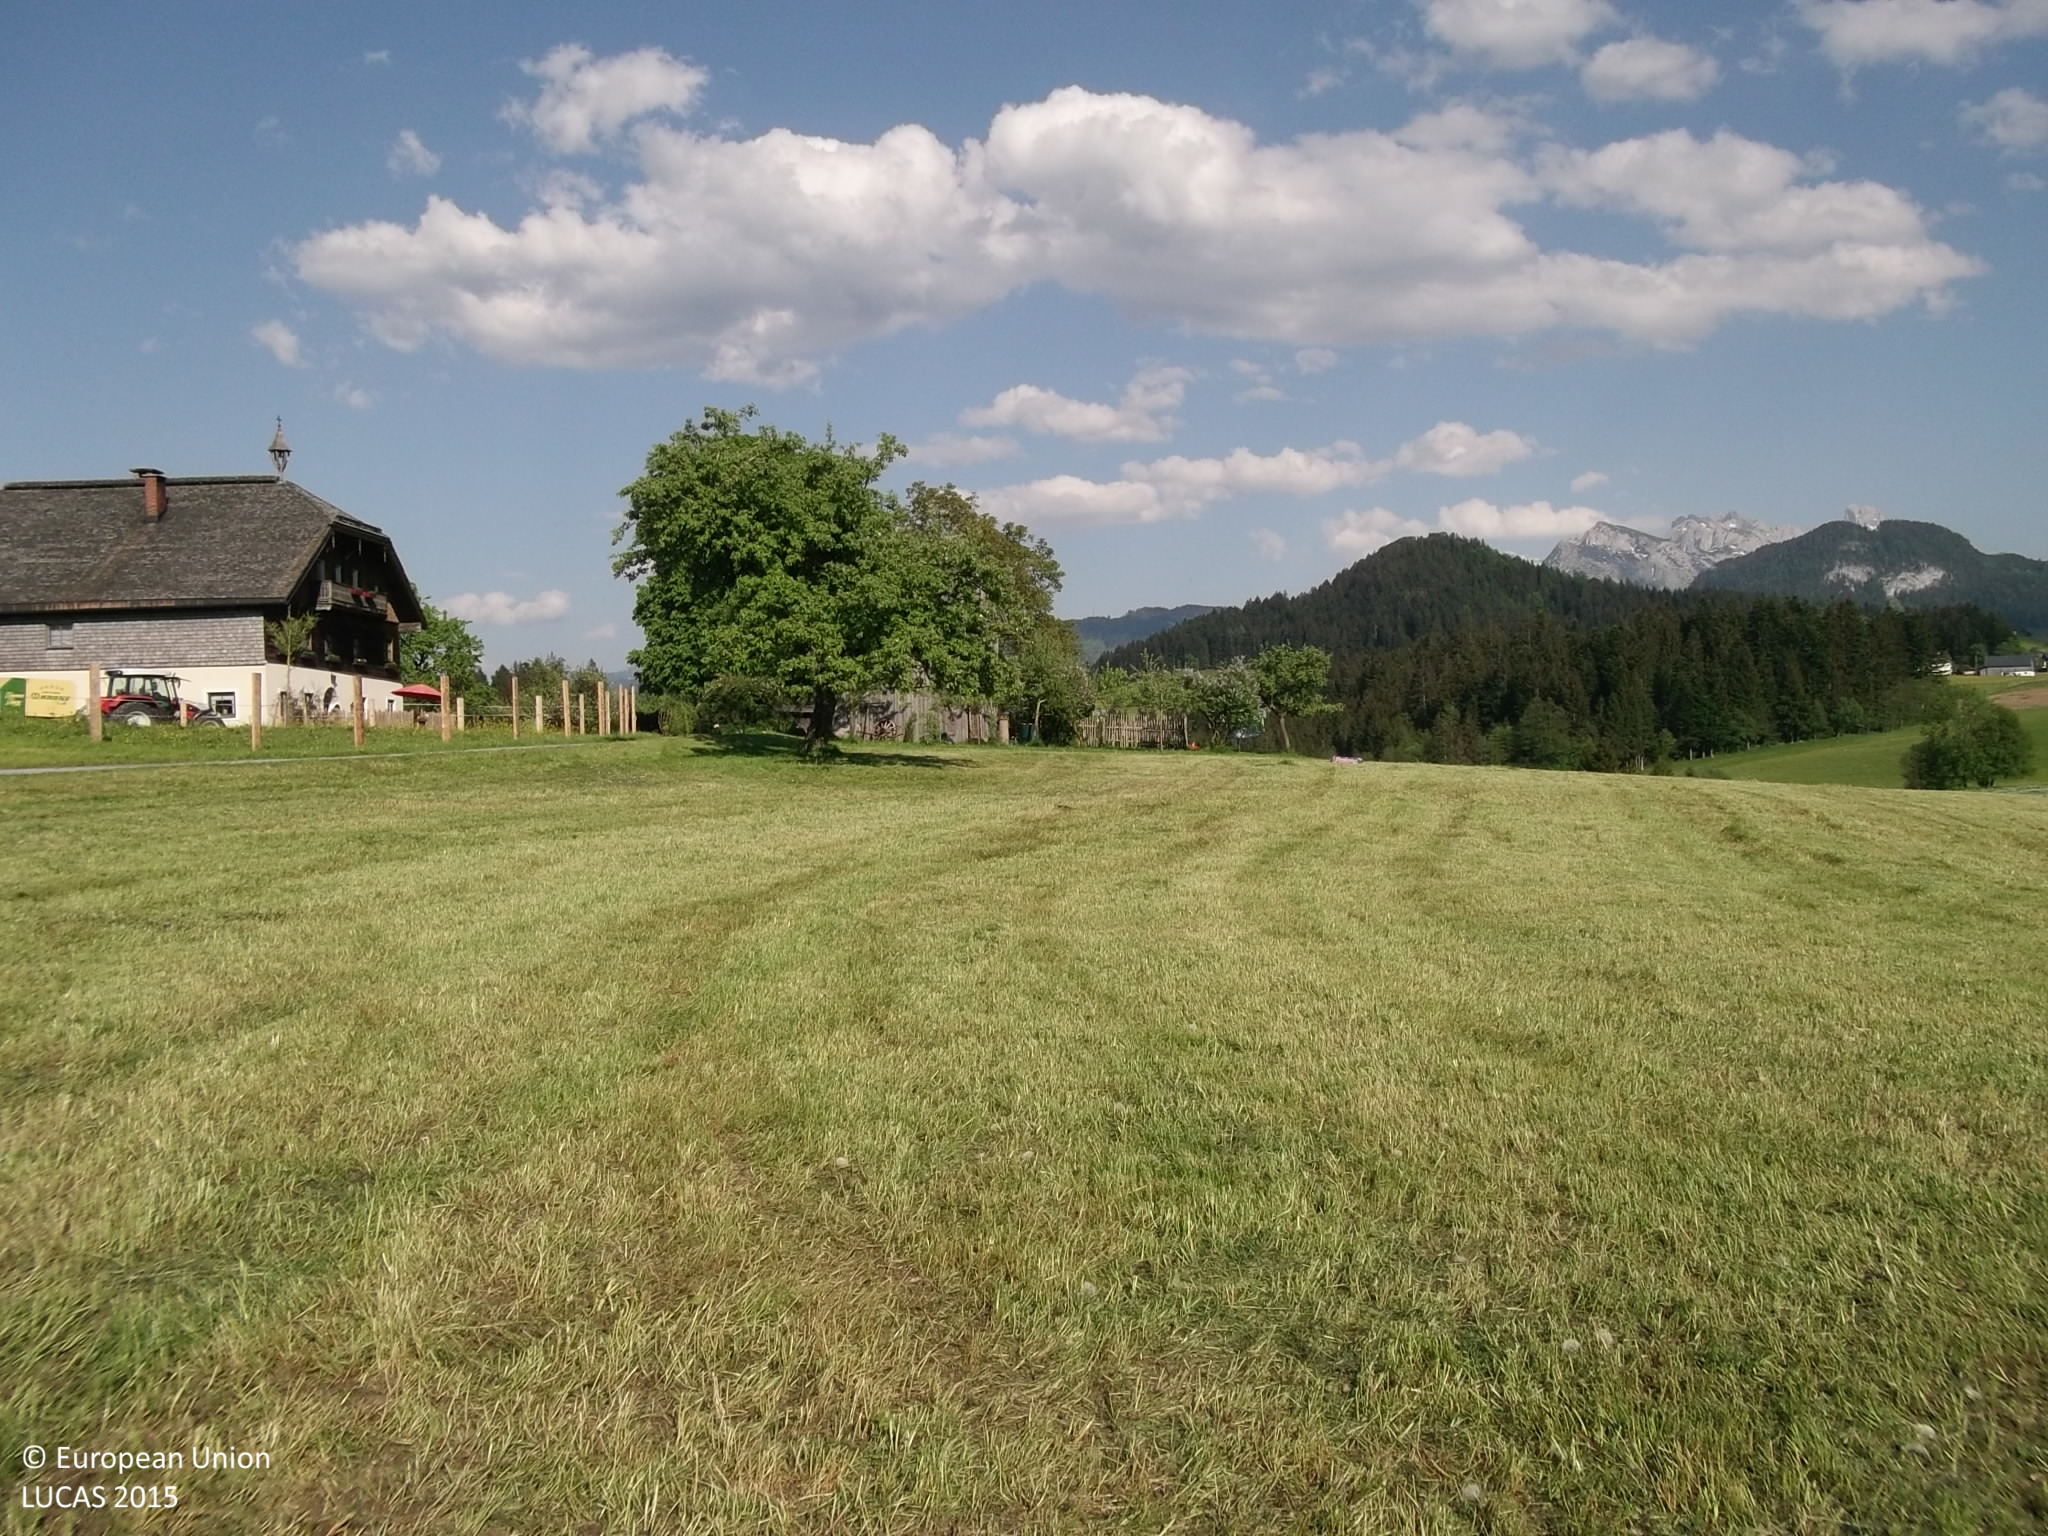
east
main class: Grassland
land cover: Grassland without tree/shrub cover
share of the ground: > 75 %
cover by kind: herbaceous plants 100 %
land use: Agriculture (excluding fallow land and kitchen gardens)
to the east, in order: Grassland without tree/shrub cover; Apple fruit; Grassland with sparse tree/shrub cover; Artificial constructions in urban areas; Apple fruit; Grassland with sparse tree/shrub cover; Grassland without tree/shrub cover; Inland marshes
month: May
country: AT
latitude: 47.5787
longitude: 13.3355
